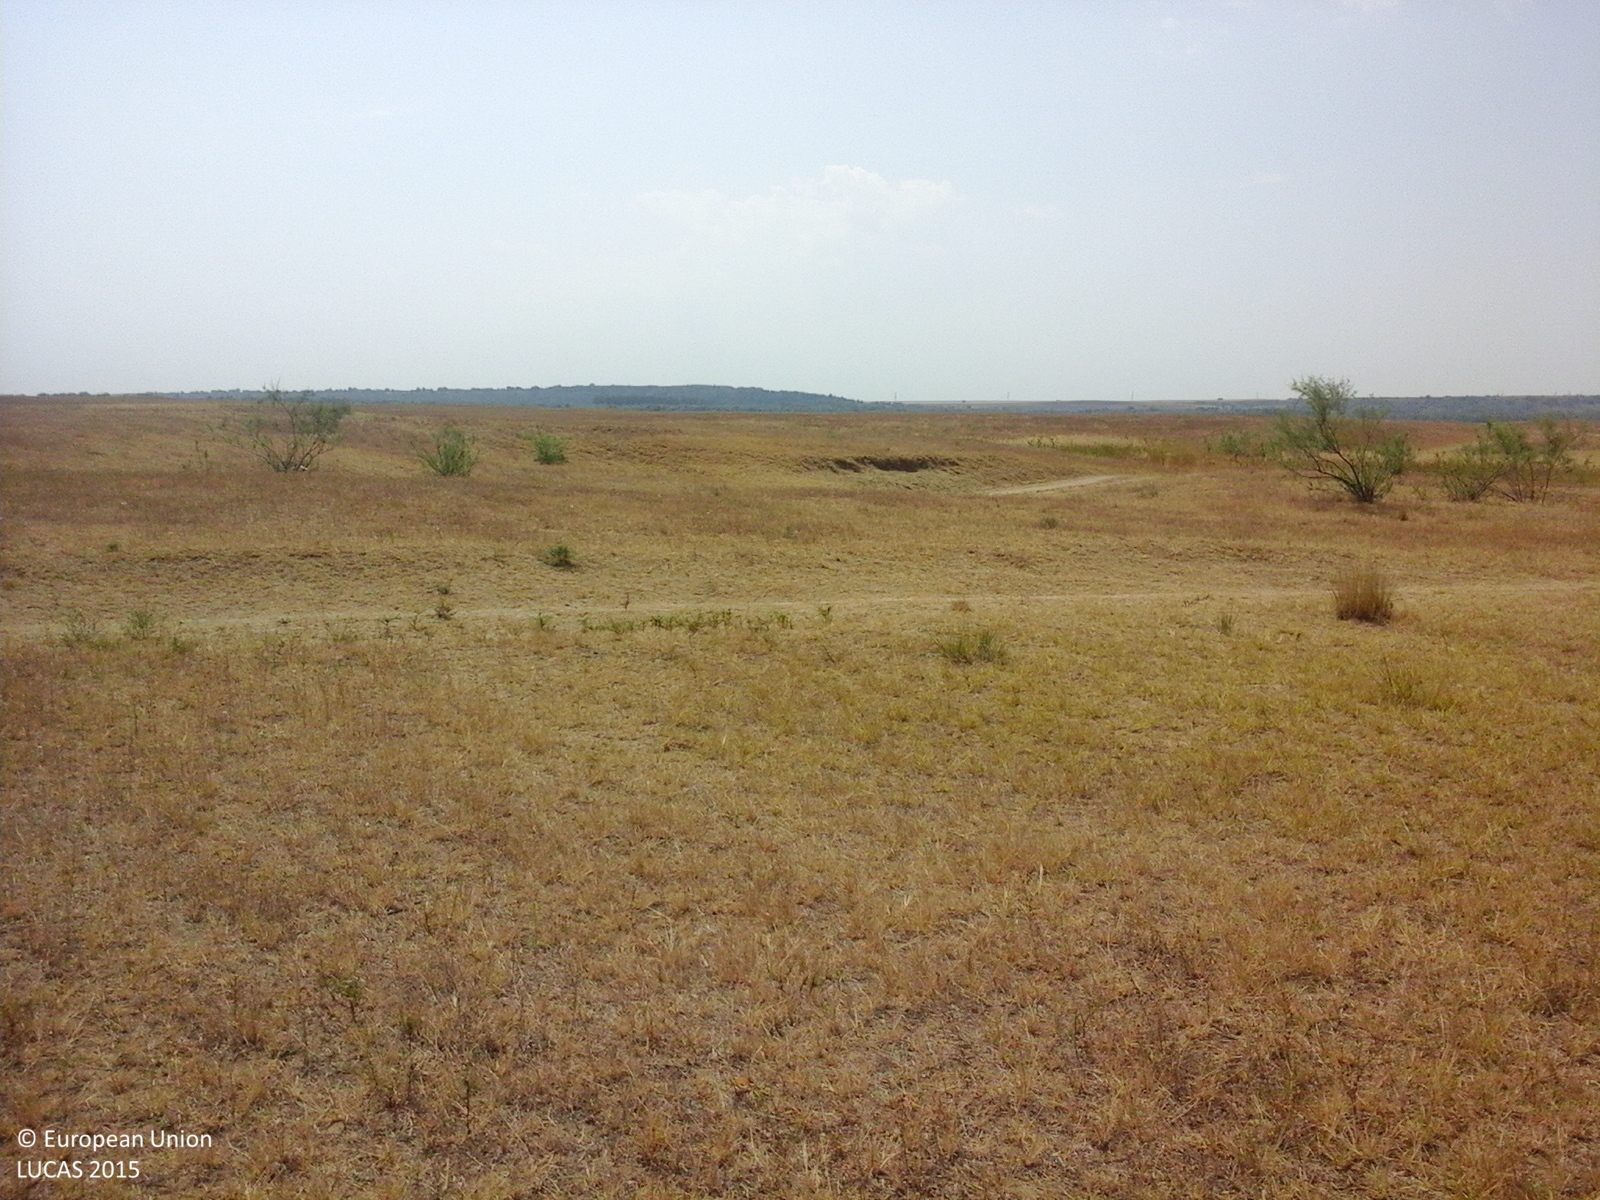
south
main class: Grassland
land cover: Grassland without tree/shrub cover
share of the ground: > 75 %
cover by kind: herbaceous plants 100 %
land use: Agriculture (excluding fallow land and kitchen gardens)
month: August
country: RO
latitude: 43.8253
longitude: 23.6659
